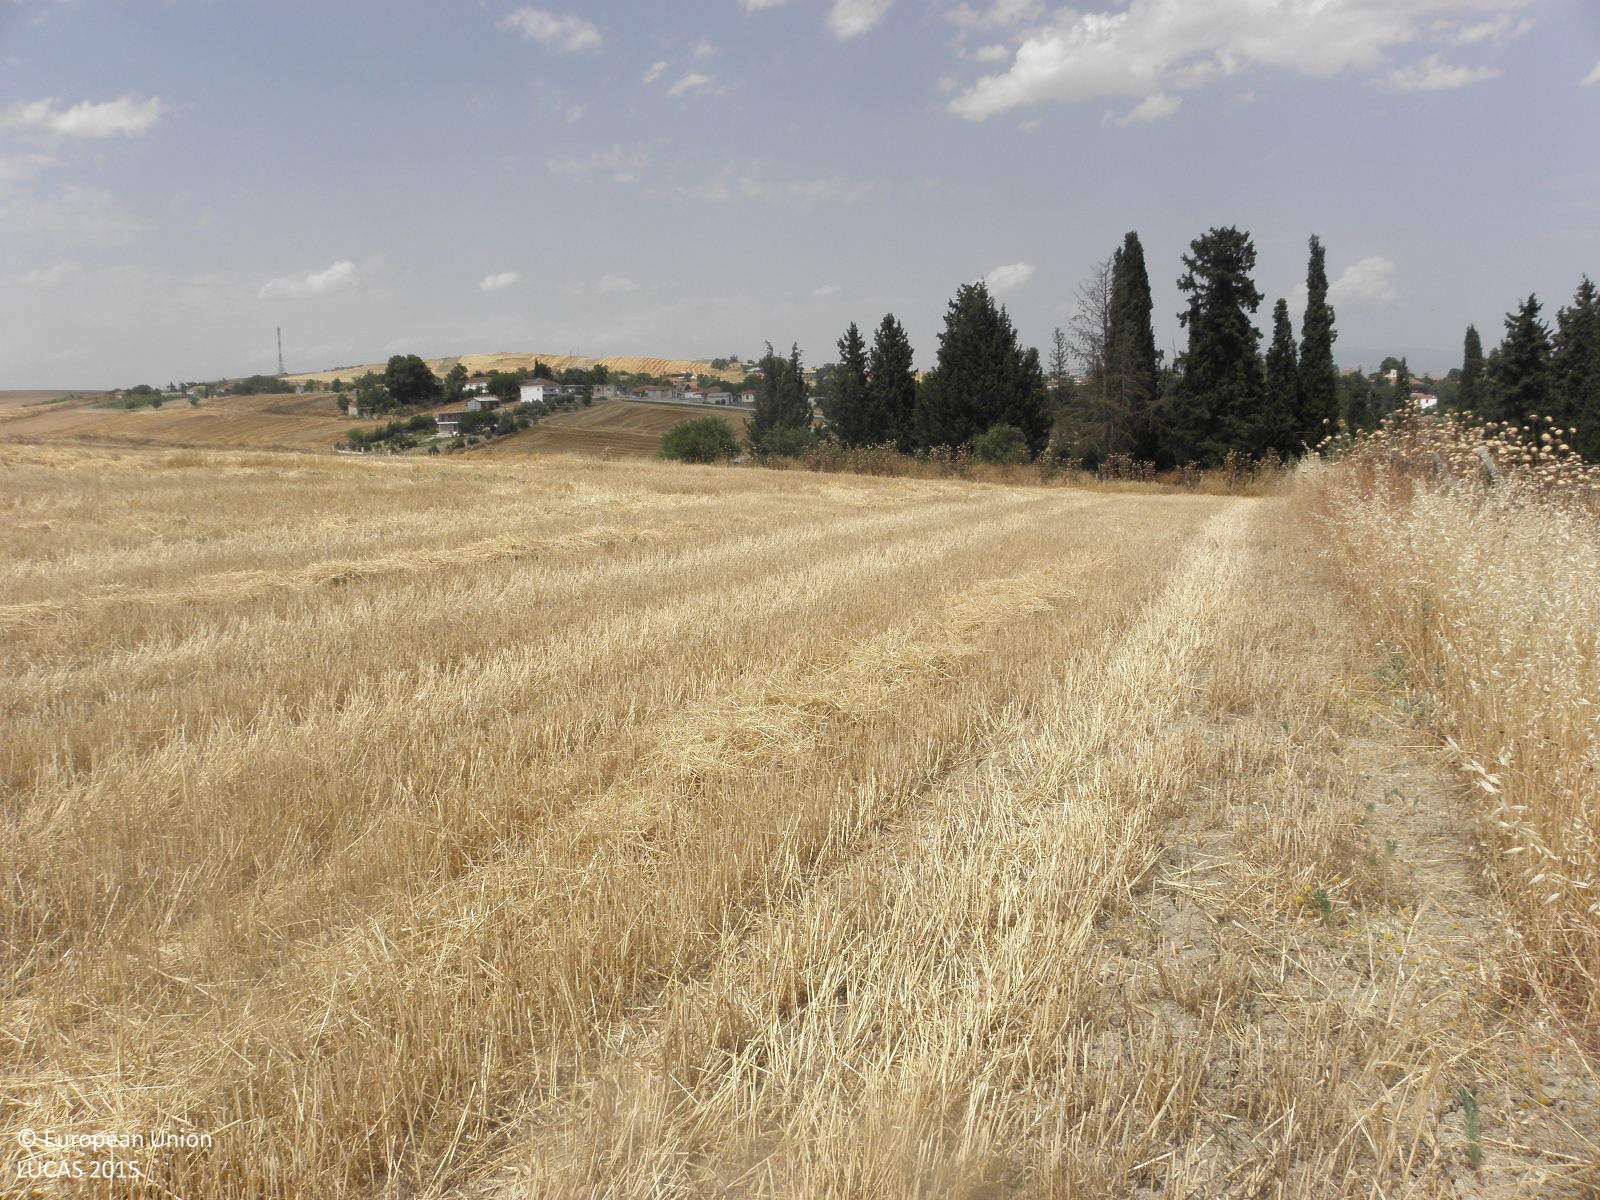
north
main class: Grassland
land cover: Spontaneously vegetated surfaces
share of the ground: > 75 %
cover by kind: herbaceous plants 100 %
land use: Fallow land
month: June
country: GR
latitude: 39.5053
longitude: 22.4674
